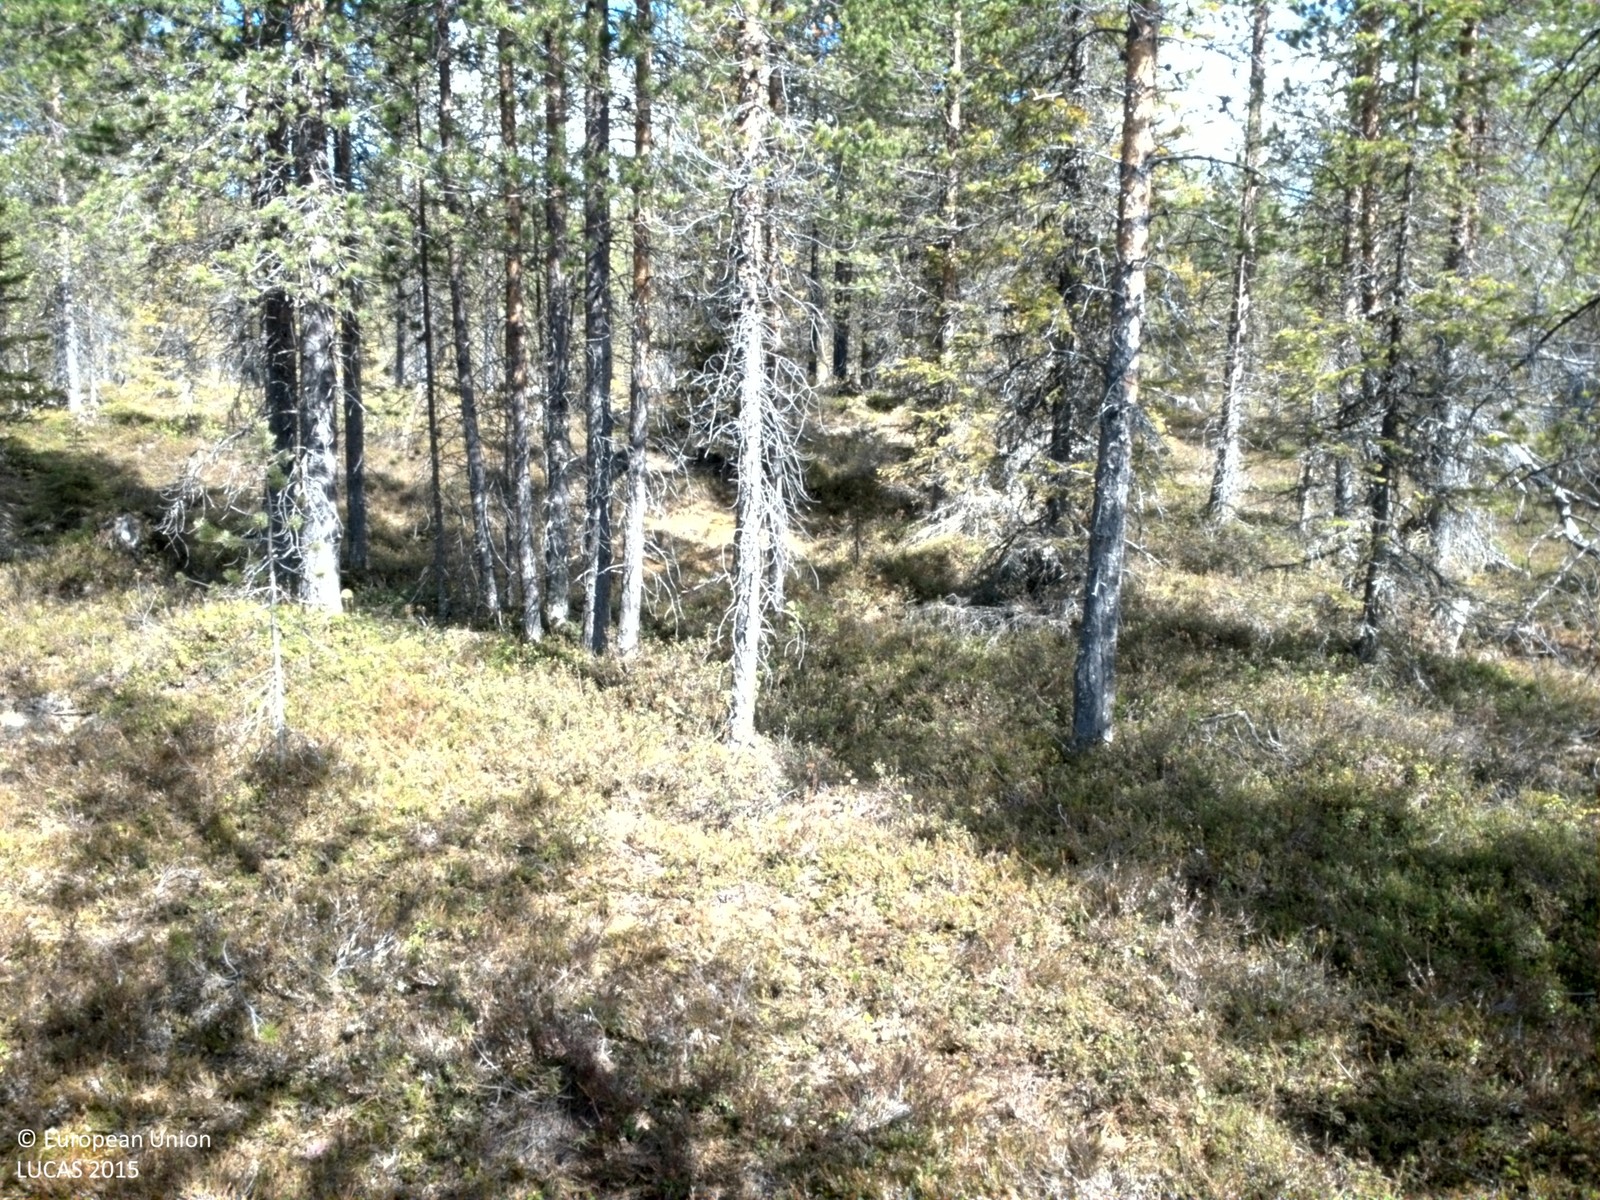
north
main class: Woodland
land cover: Pine dominated coniferous woodland
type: boreal forest
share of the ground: 25 - 50 %
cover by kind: shrubs 55 %, coniferous forest trees 40 %, lichens and mosses 5 %
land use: Forestry
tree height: > 5 m
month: June
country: SE
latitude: 65.9458
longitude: 18.6410
